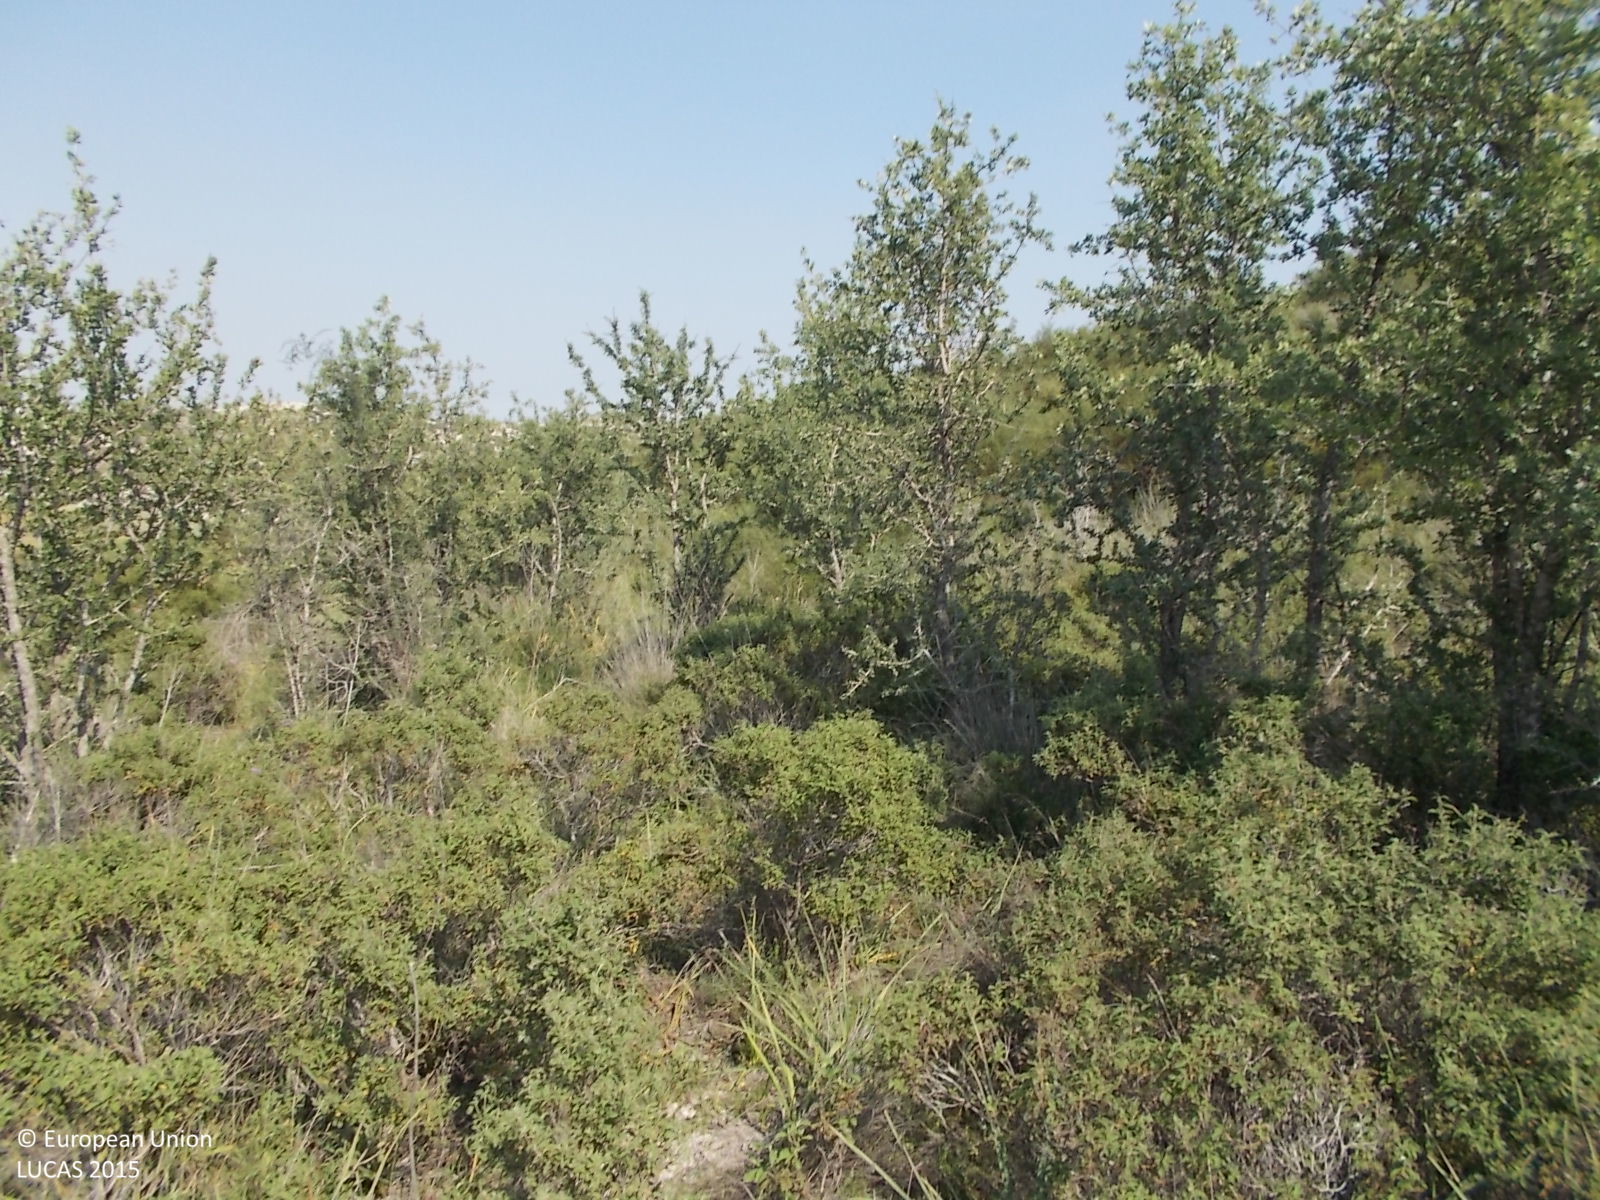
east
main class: Woodland
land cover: Broadleaved woodland
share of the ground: 10 - 25 %
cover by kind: shrubs 85 %, broadleaved forest trees 15 %
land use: Semi-natural and natural areas not in use
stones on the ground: < 10 %
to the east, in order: Broadleaved woodland; Shrubland with sparse tree cover; Shrubland without tree cover
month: April
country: CY
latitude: 34.8934
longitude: 33.4865
